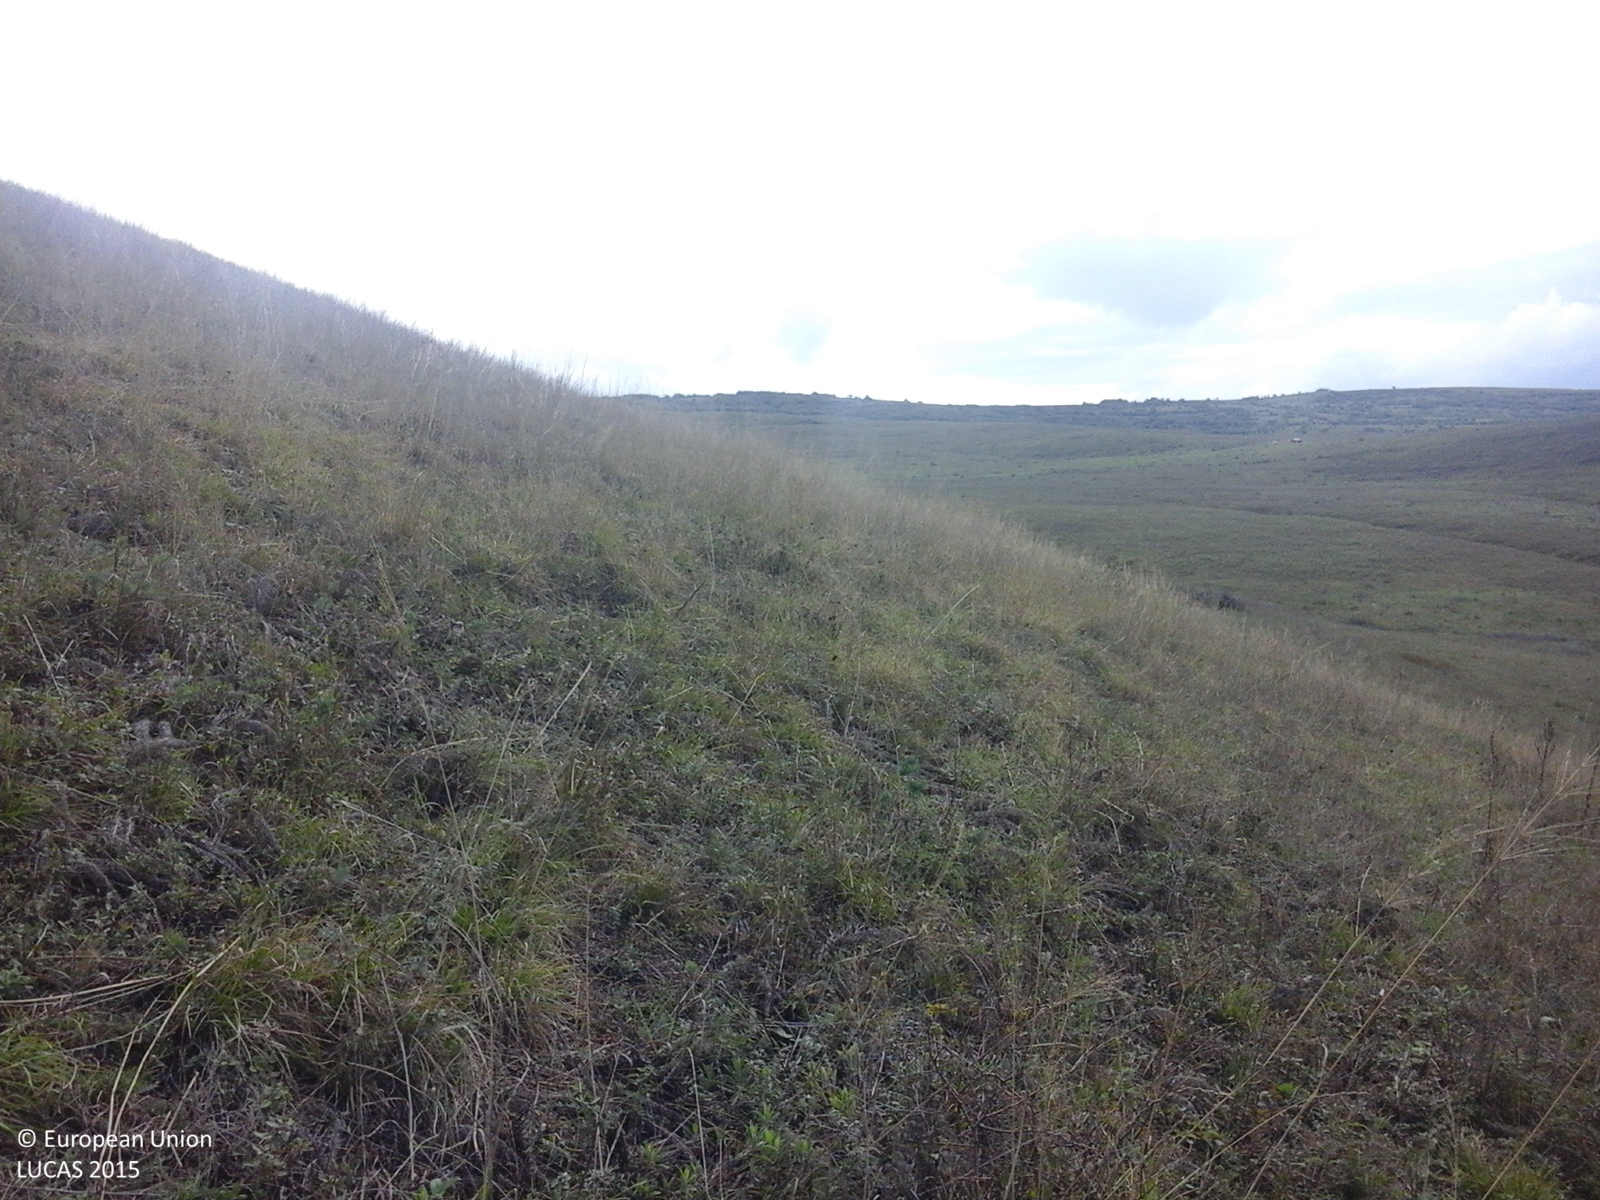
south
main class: Grassland
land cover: Grassland without tree/shrub cover
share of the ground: > 75 %
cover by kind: herbaceous plants 100 %
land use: Agriculture (excluding fallow land and kitchen gardens)
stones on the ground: < 10 %
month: September
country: RO
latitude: 46.0629
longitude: 23.7329
